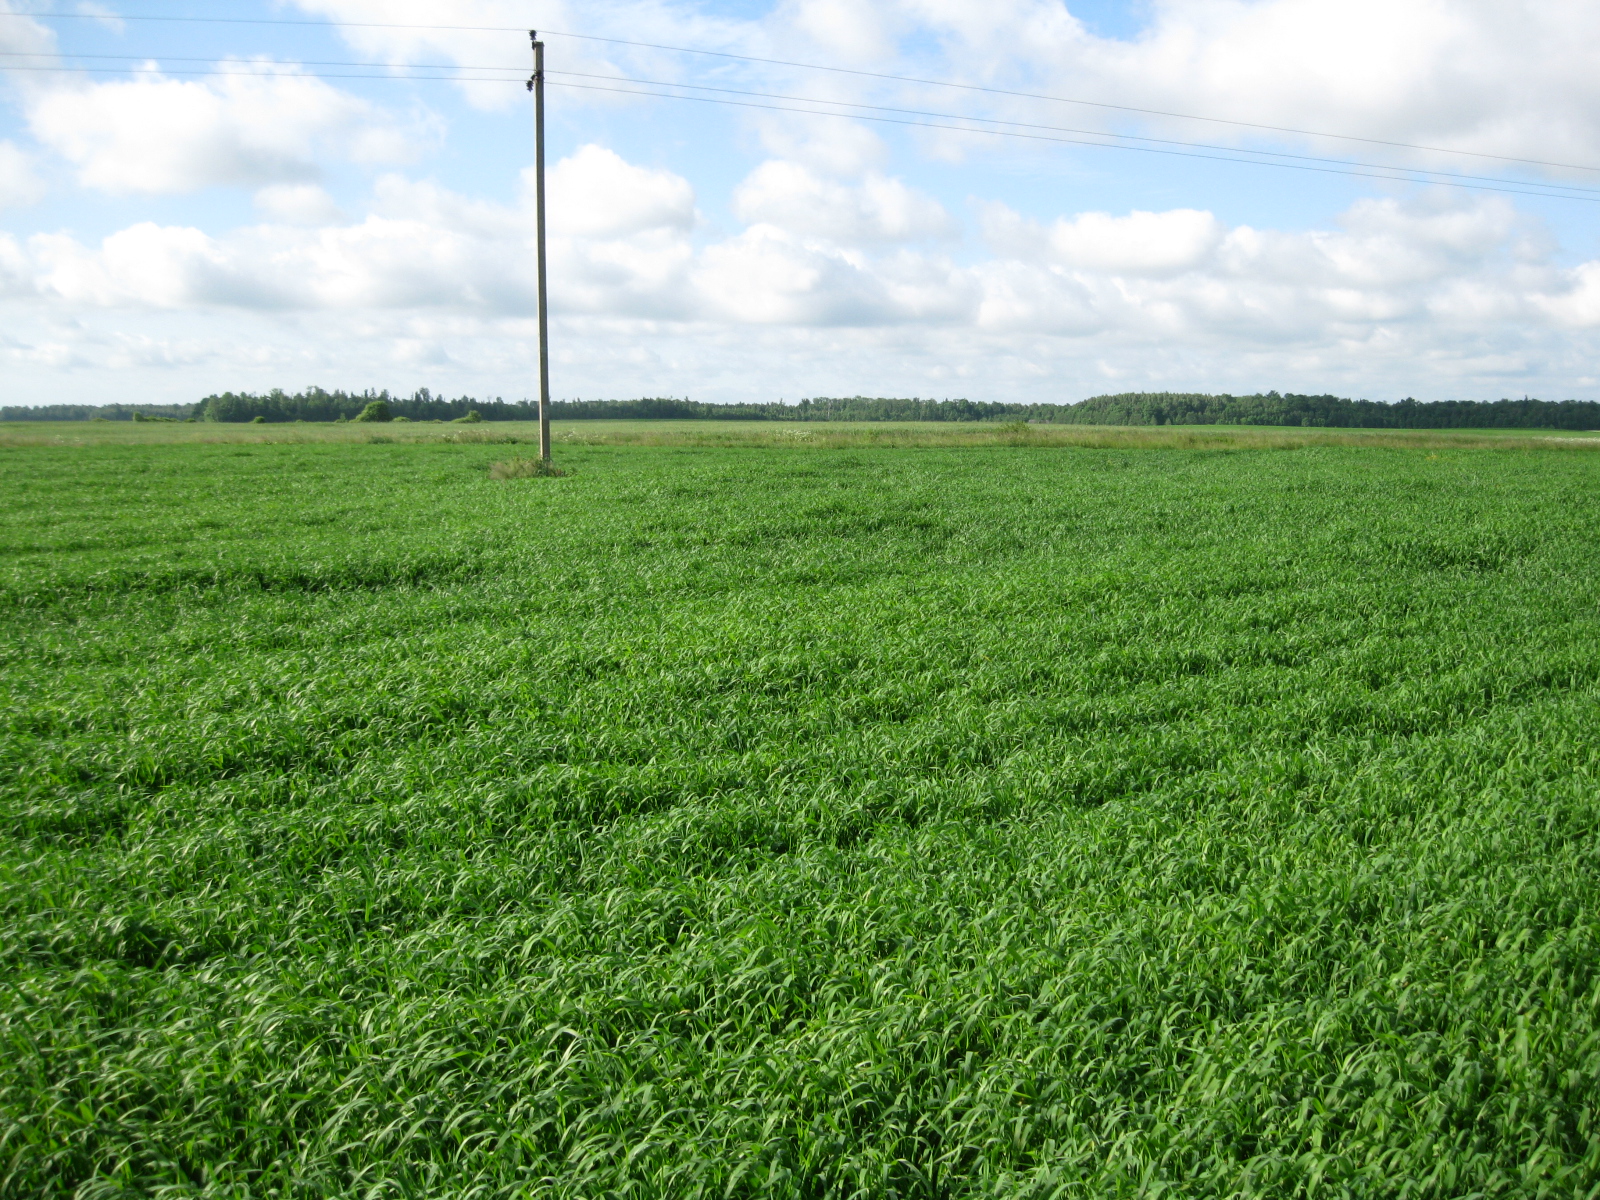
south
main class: Cropland
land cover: Barley
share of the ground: > 75 %
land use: Agriculture (excluding fallow land and kitchen gardens)
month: June
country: LT
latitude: 55.1921
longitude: 23.7031
